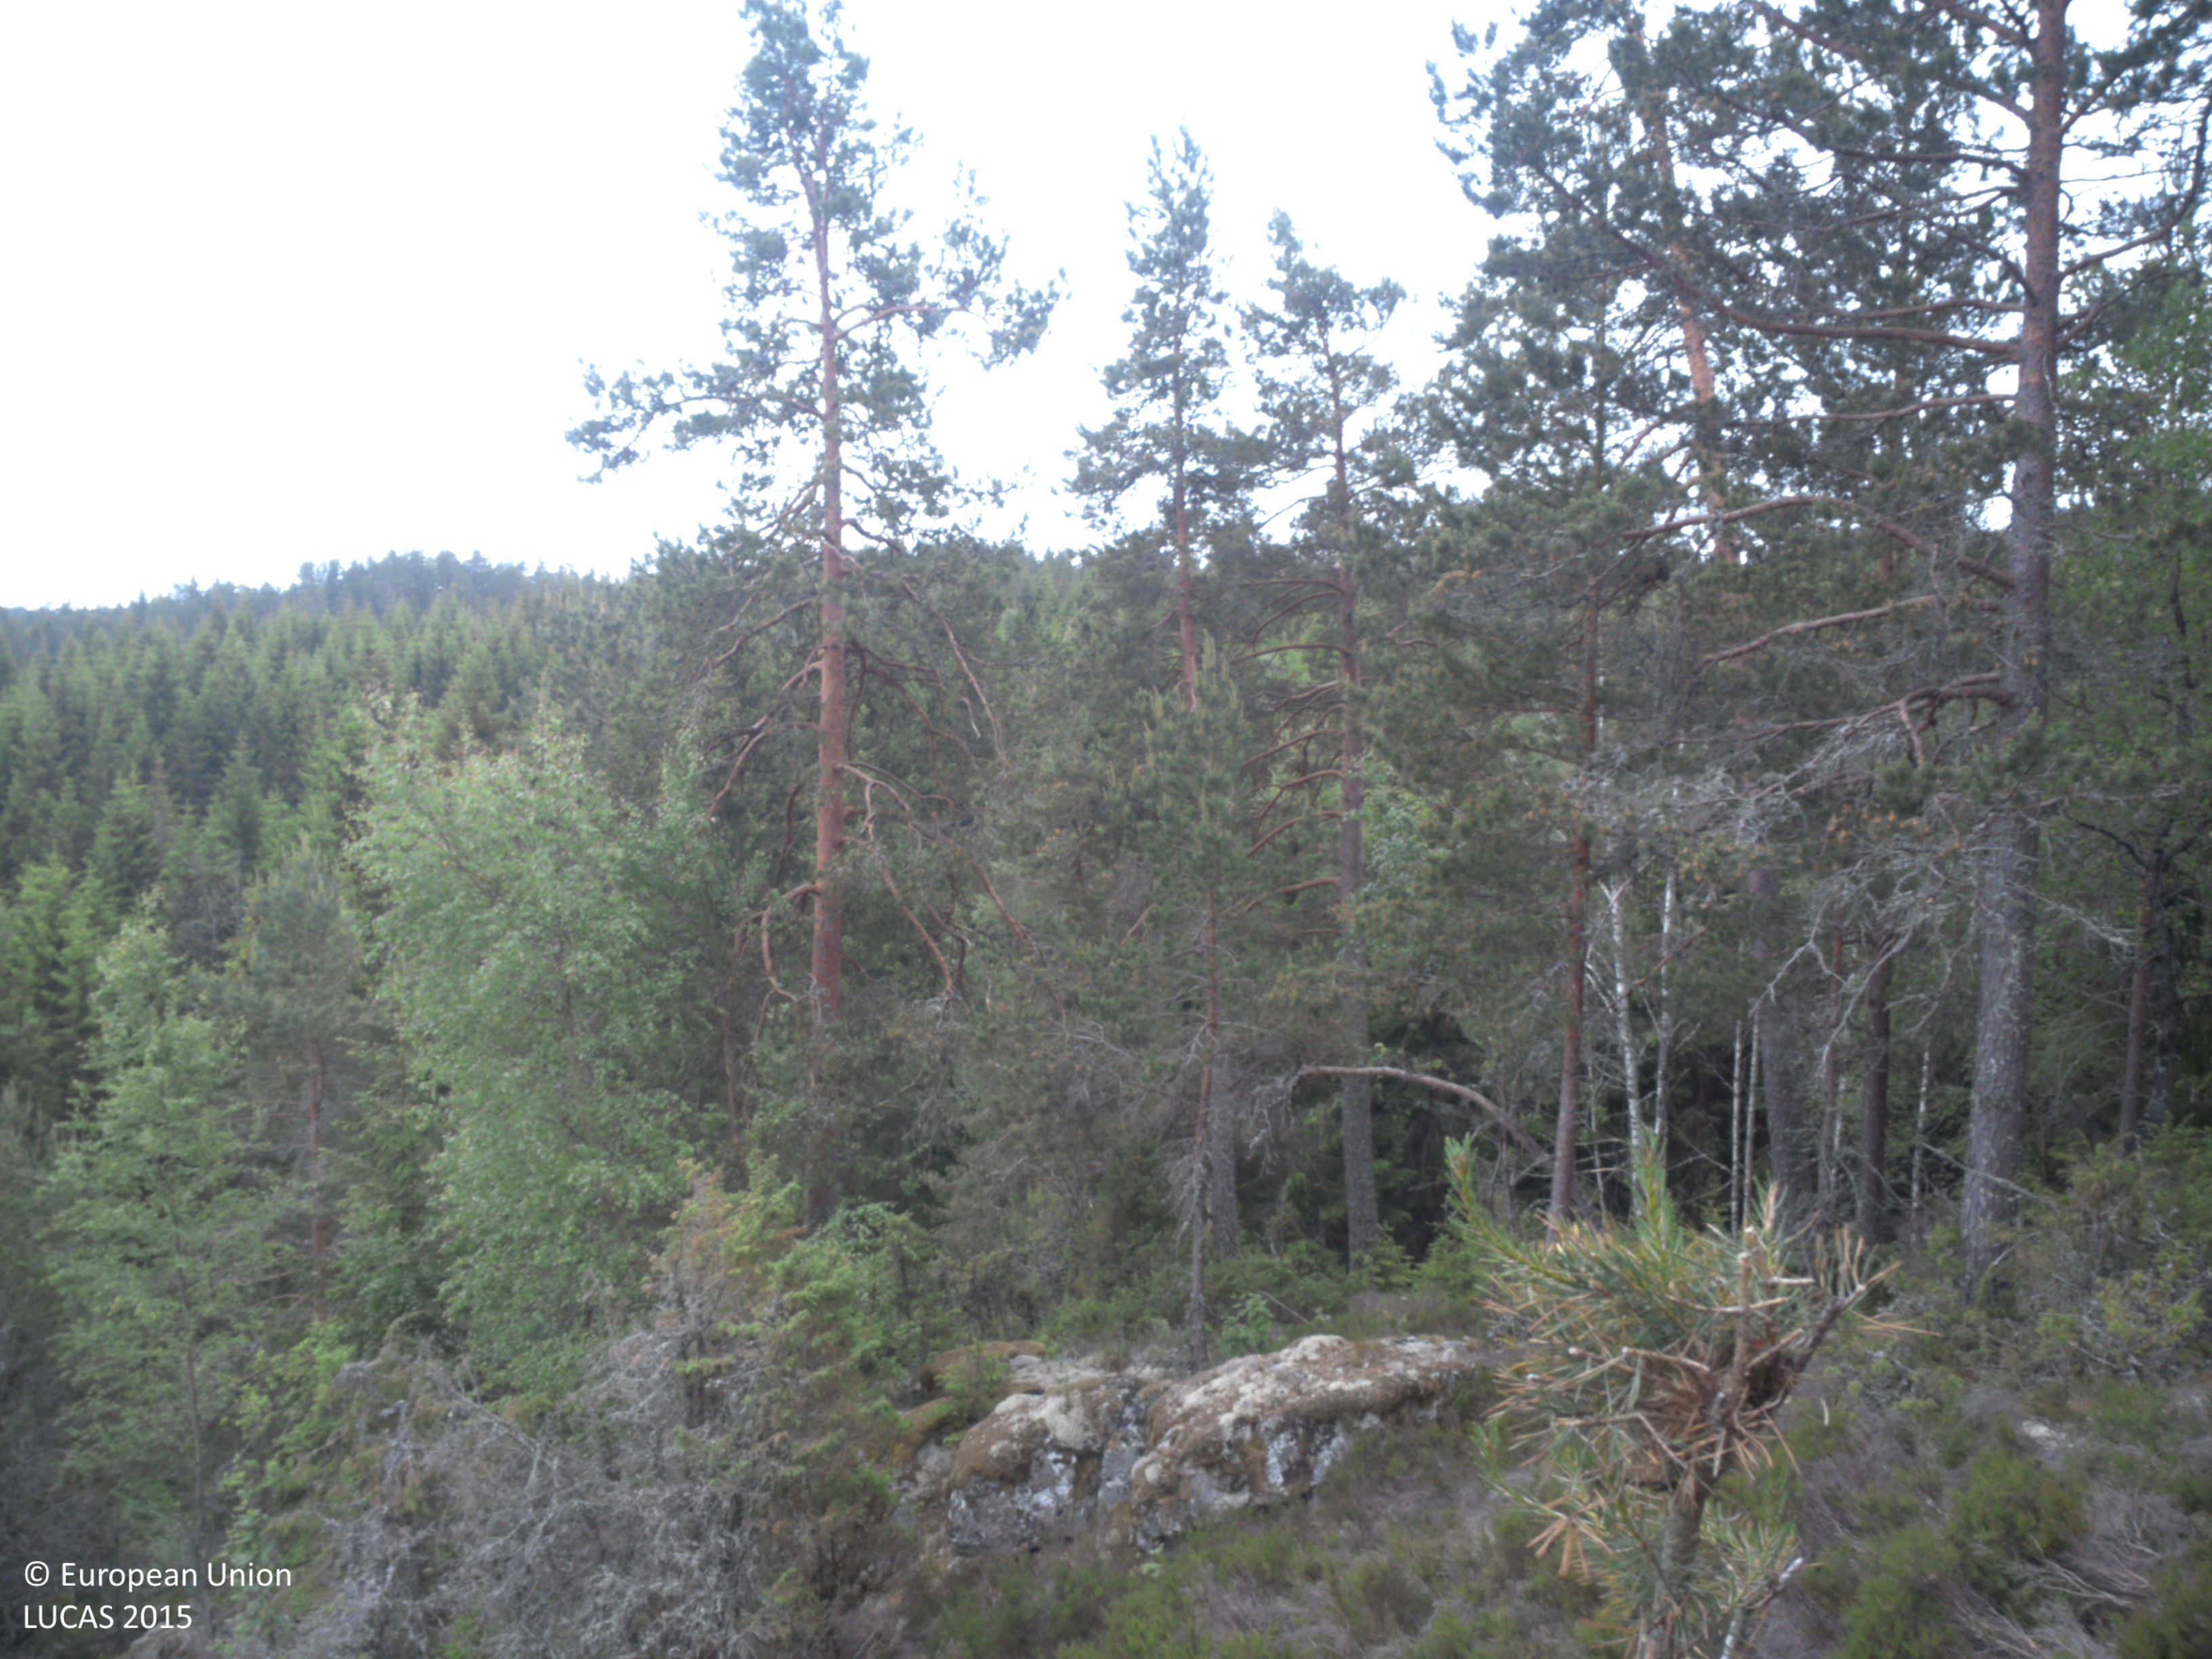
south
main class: Woodland
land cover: Pine dominated coniferous woodland
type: boreal forest
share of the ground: 25 - 50 %
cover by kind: coniferous forest trees 30 %, shrubs 25 %, herbaceous plants 15 %, lichens and mosses 15 %, consolidated bare surface 15 %
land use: Forestry
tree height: > 5 m
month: June
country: SE
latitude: 59.1947
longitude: 11.9734
